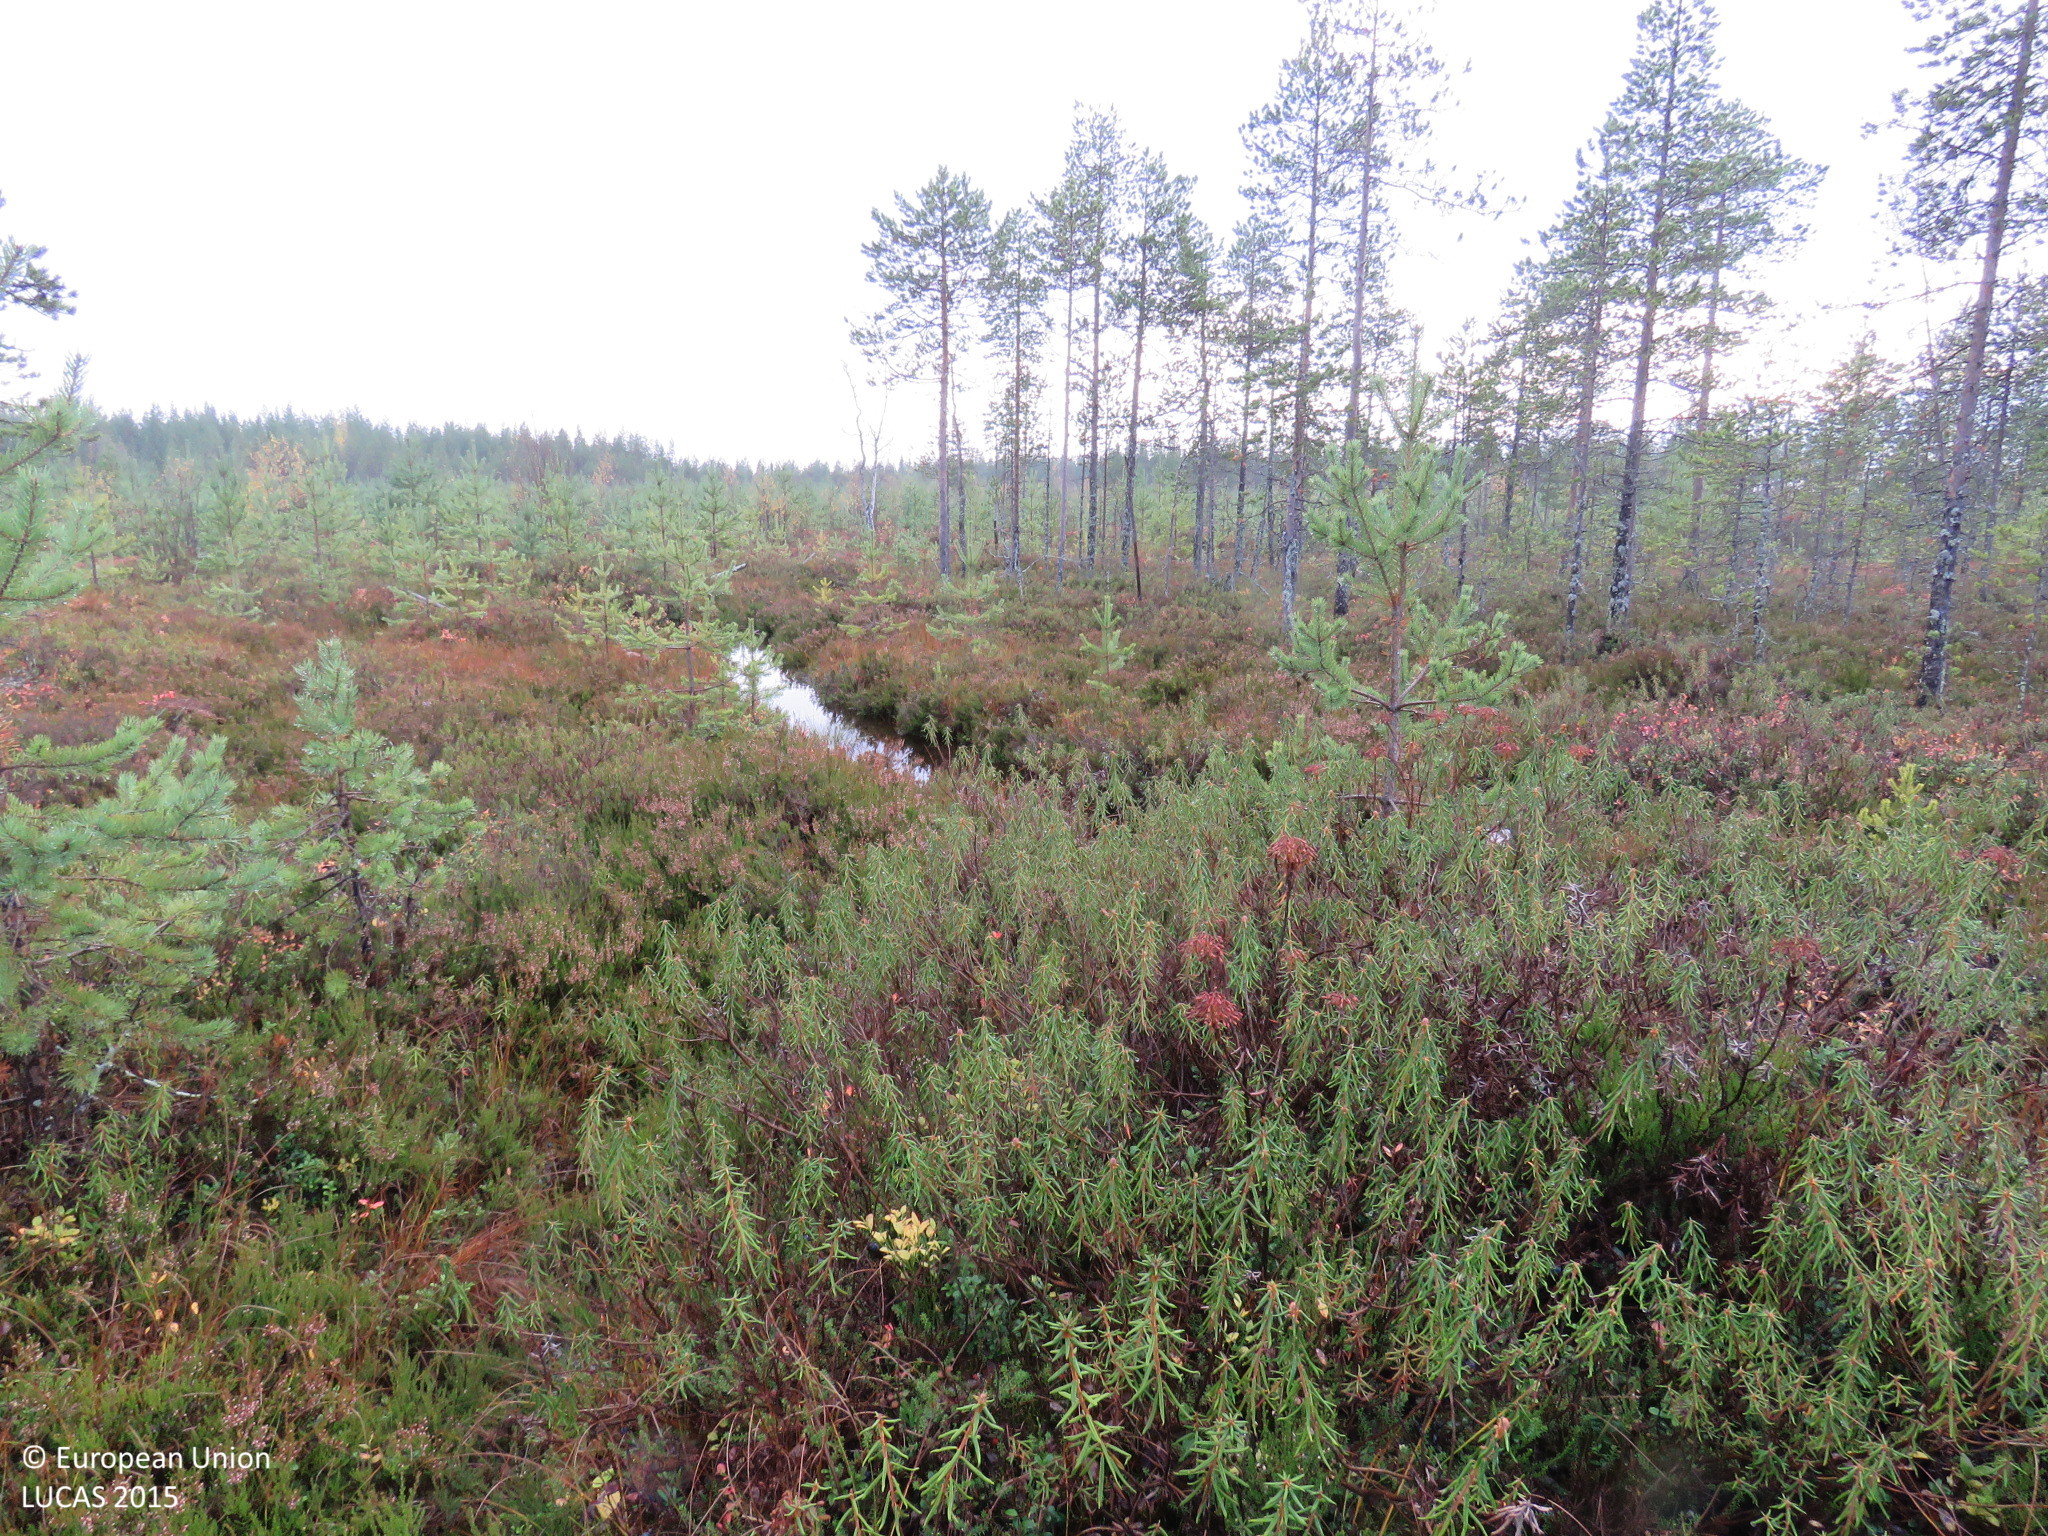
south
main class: Woodland
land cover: Pine dominated coniferous woodland
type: boreal forest
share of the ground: 50 - 75 %
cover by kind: coniferous forest trees 60 %, shrubs 25 %, lichens and mosses 10 %, herbaceous plants 5 %
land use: Forestry
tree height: < 5 m
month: September
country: FI
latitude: 65.3491
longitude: 27.1610
